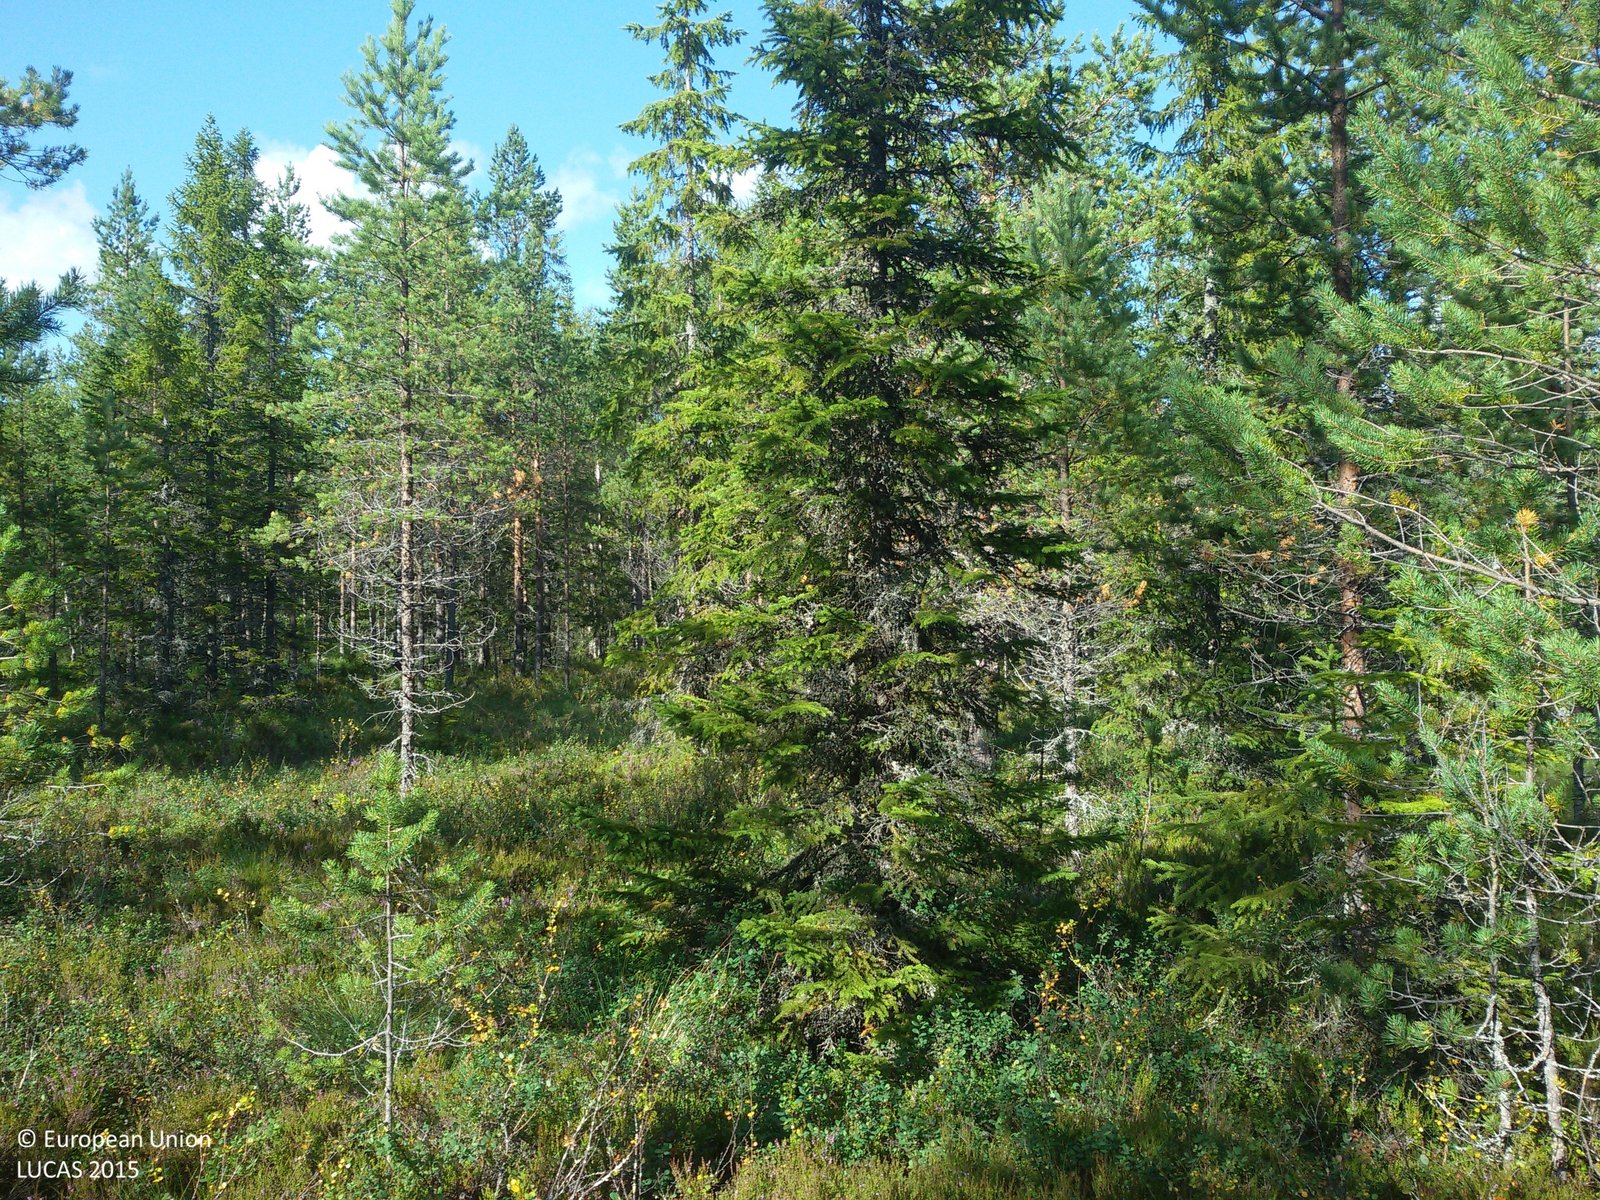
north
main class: Woodland
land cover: Pine dominated coniferous woodland
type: boreal forest
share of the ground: 50 - 75 %
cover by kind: coniferous forest trees 50 %, herbaceous plants 40 %, lichens and mosses 10 %
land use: Forestry
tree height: > 5 m
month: August
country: SE
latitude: 60.9224
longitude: 15.9443
